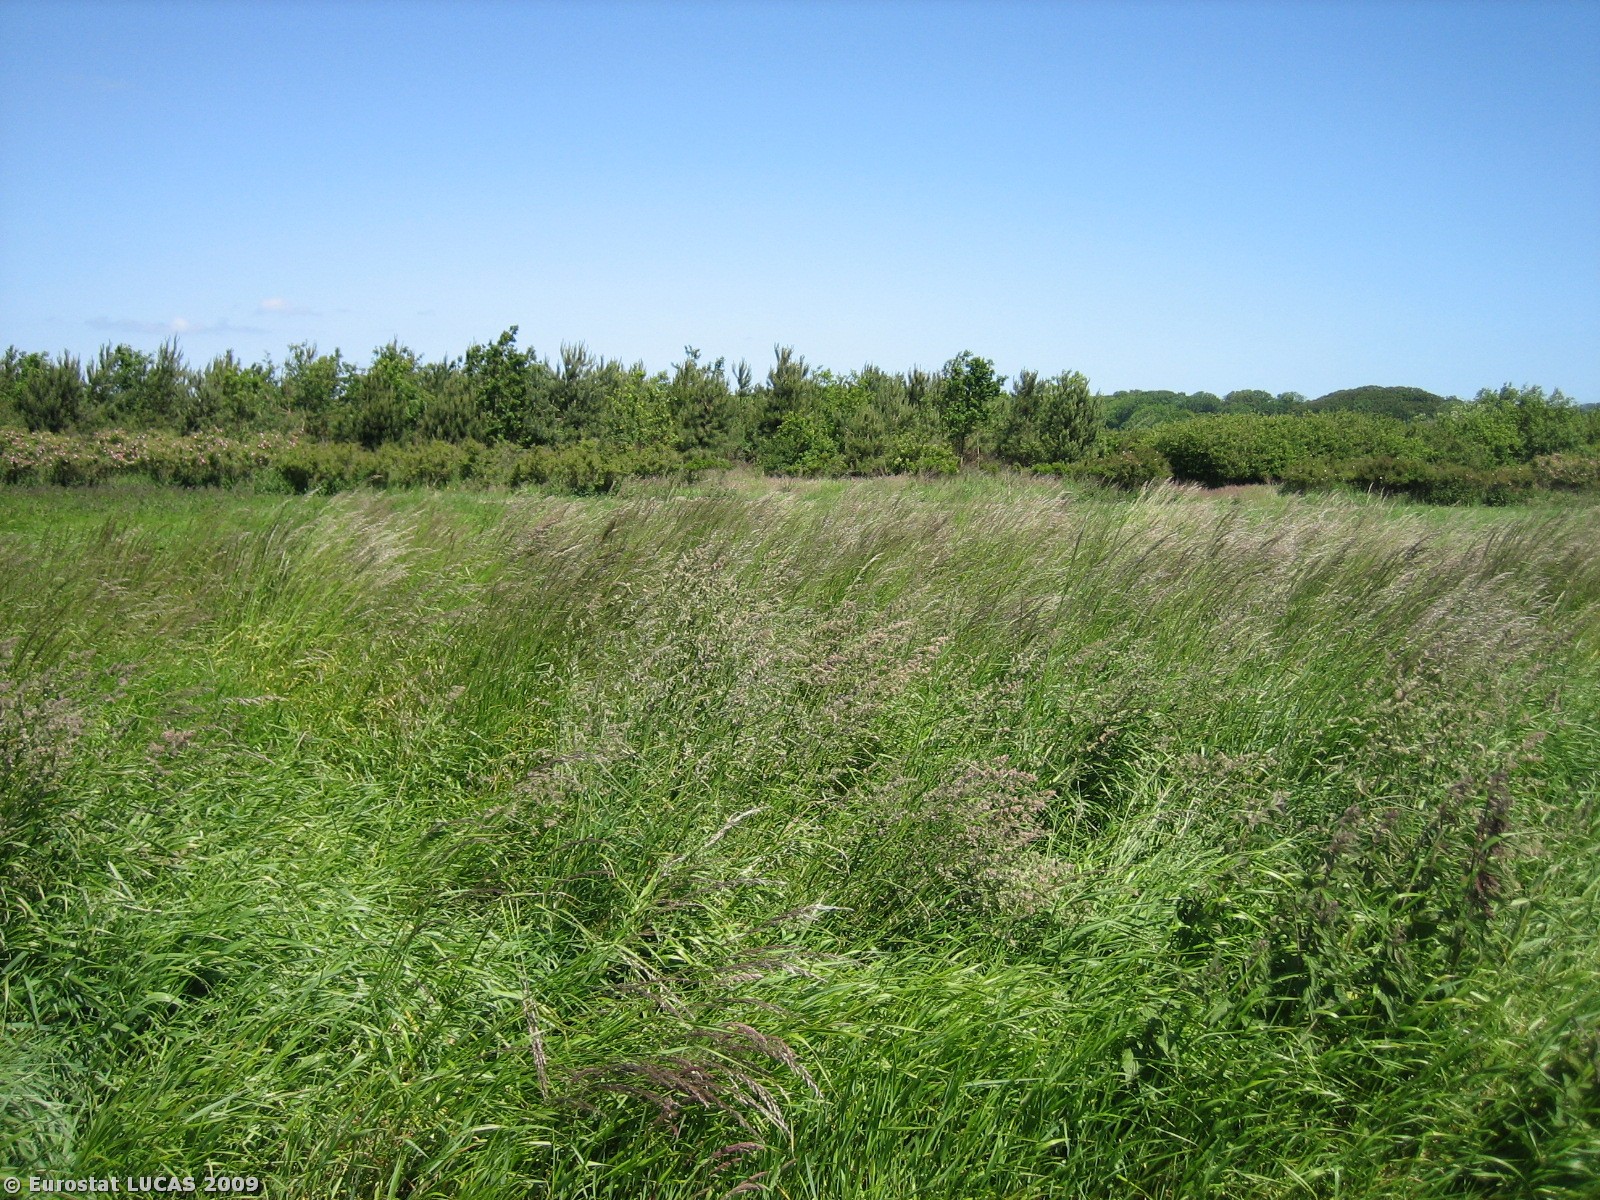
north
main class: Cropland
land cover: Rape and turnip rape
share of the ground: > 75 %
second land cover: Grassland without tree/shrub cover
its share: > 75 %
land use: Agriculture (excluding fallow land and kitchen gardens)
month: June
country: DK
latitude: 55.7384
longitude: 10.0159
